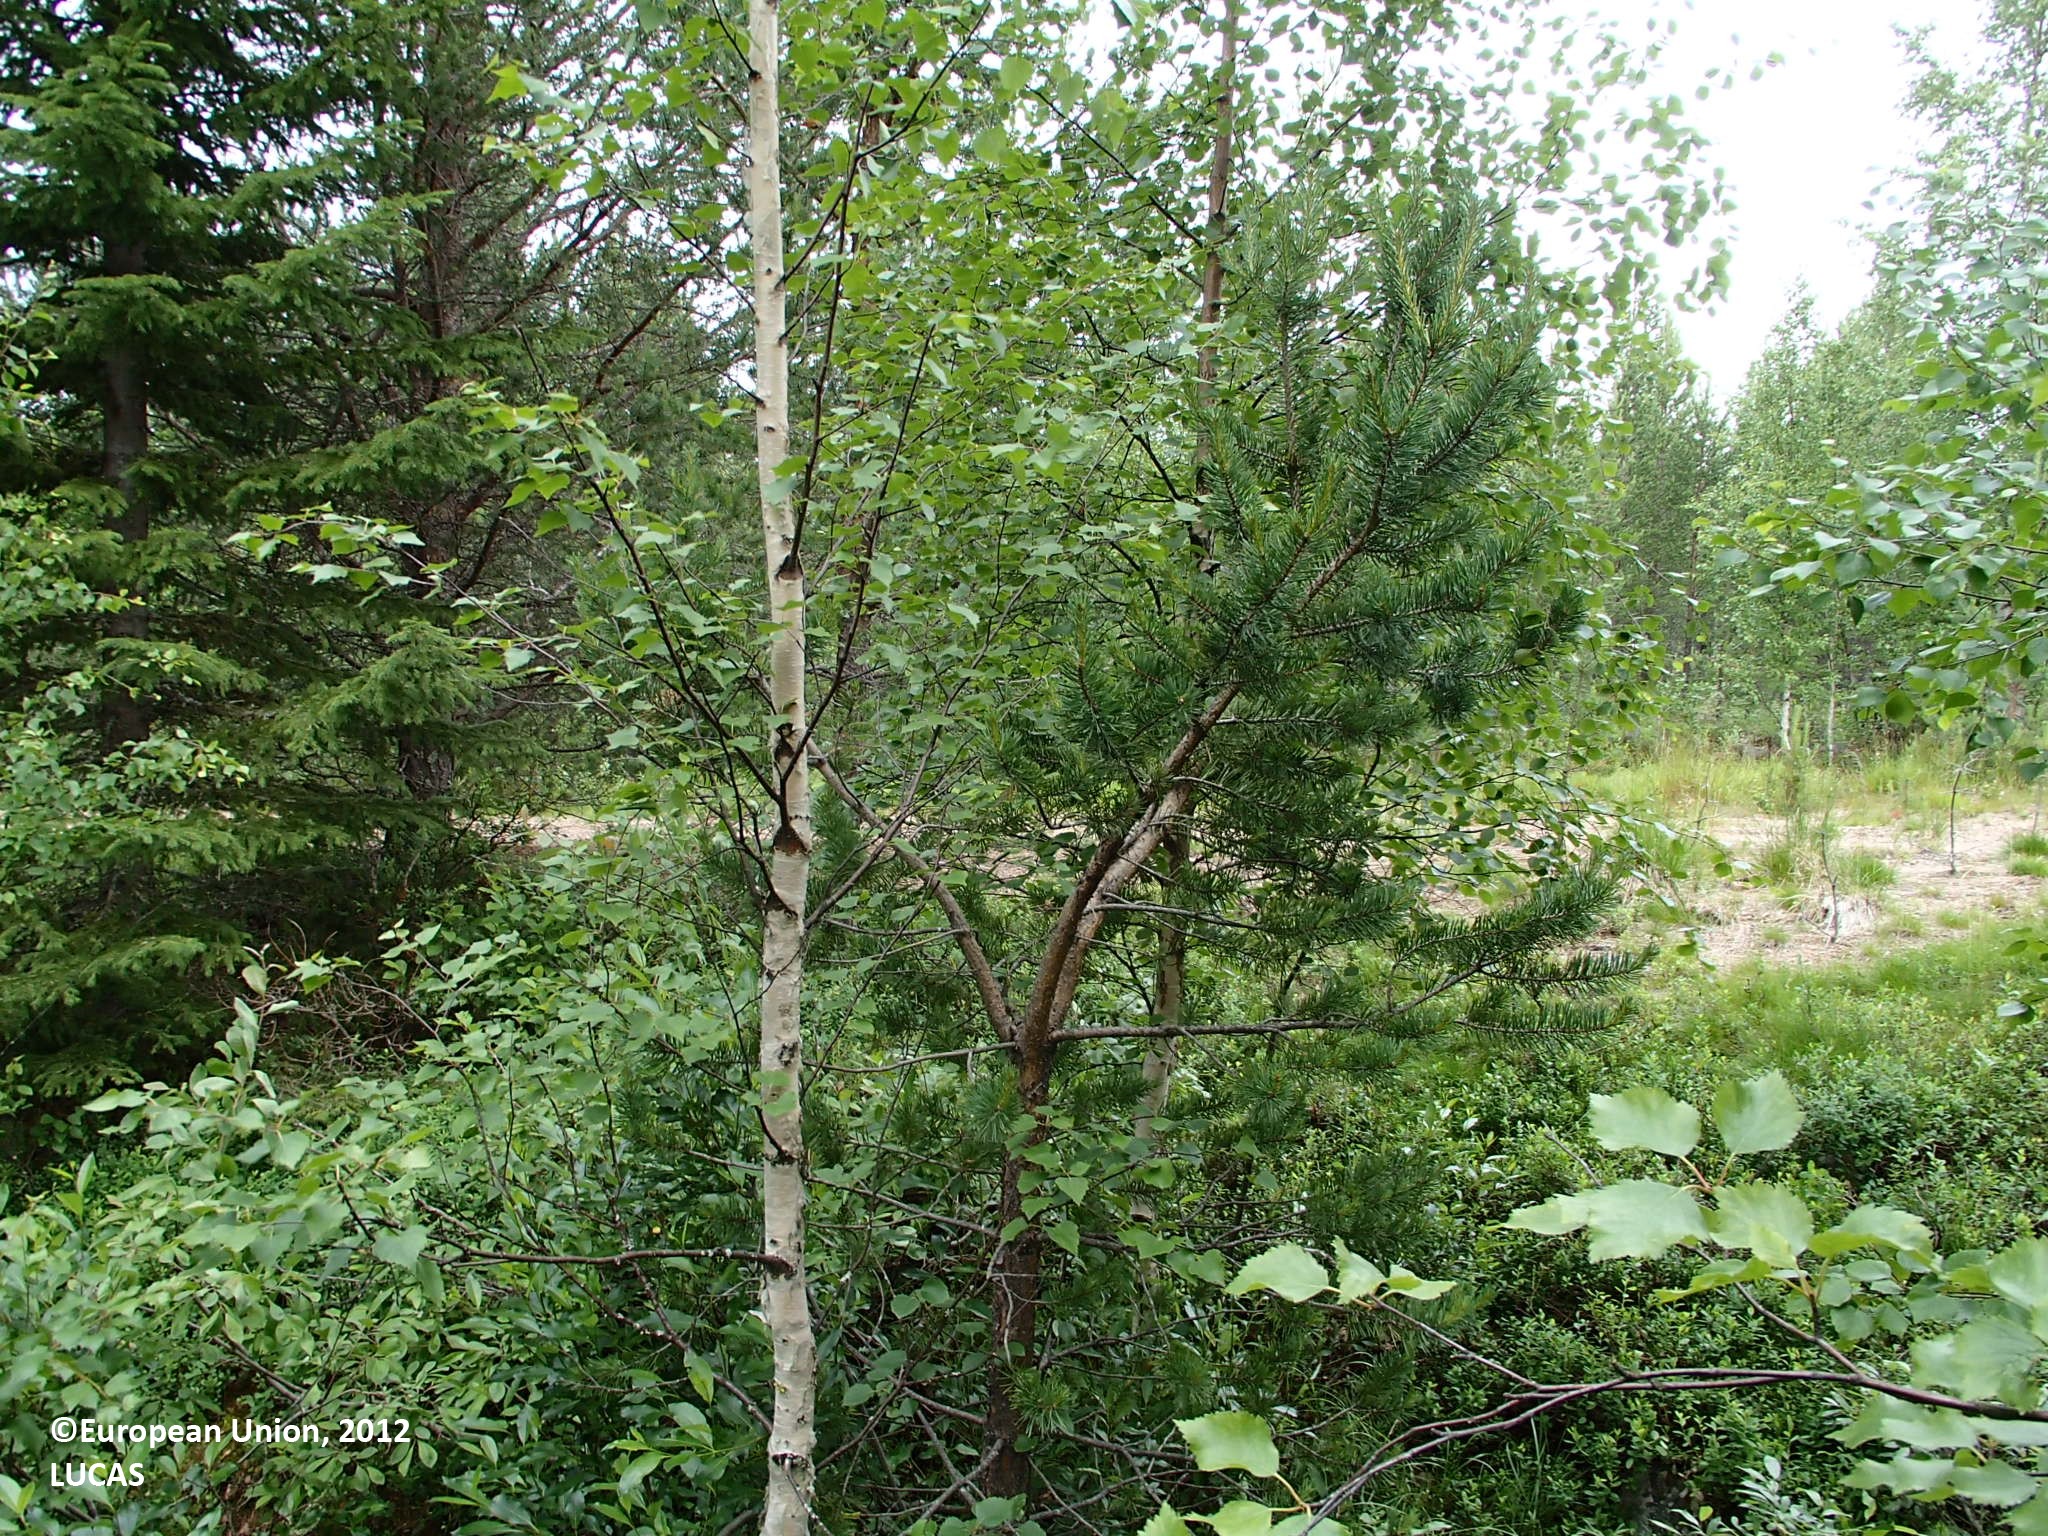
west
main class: Woodland
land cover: Other mixed woodland
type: boreal forest
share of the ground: > 75 %
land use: Forestry
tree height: > 5 m
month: July
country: FI
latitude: 66.9873
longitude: 25.4366
